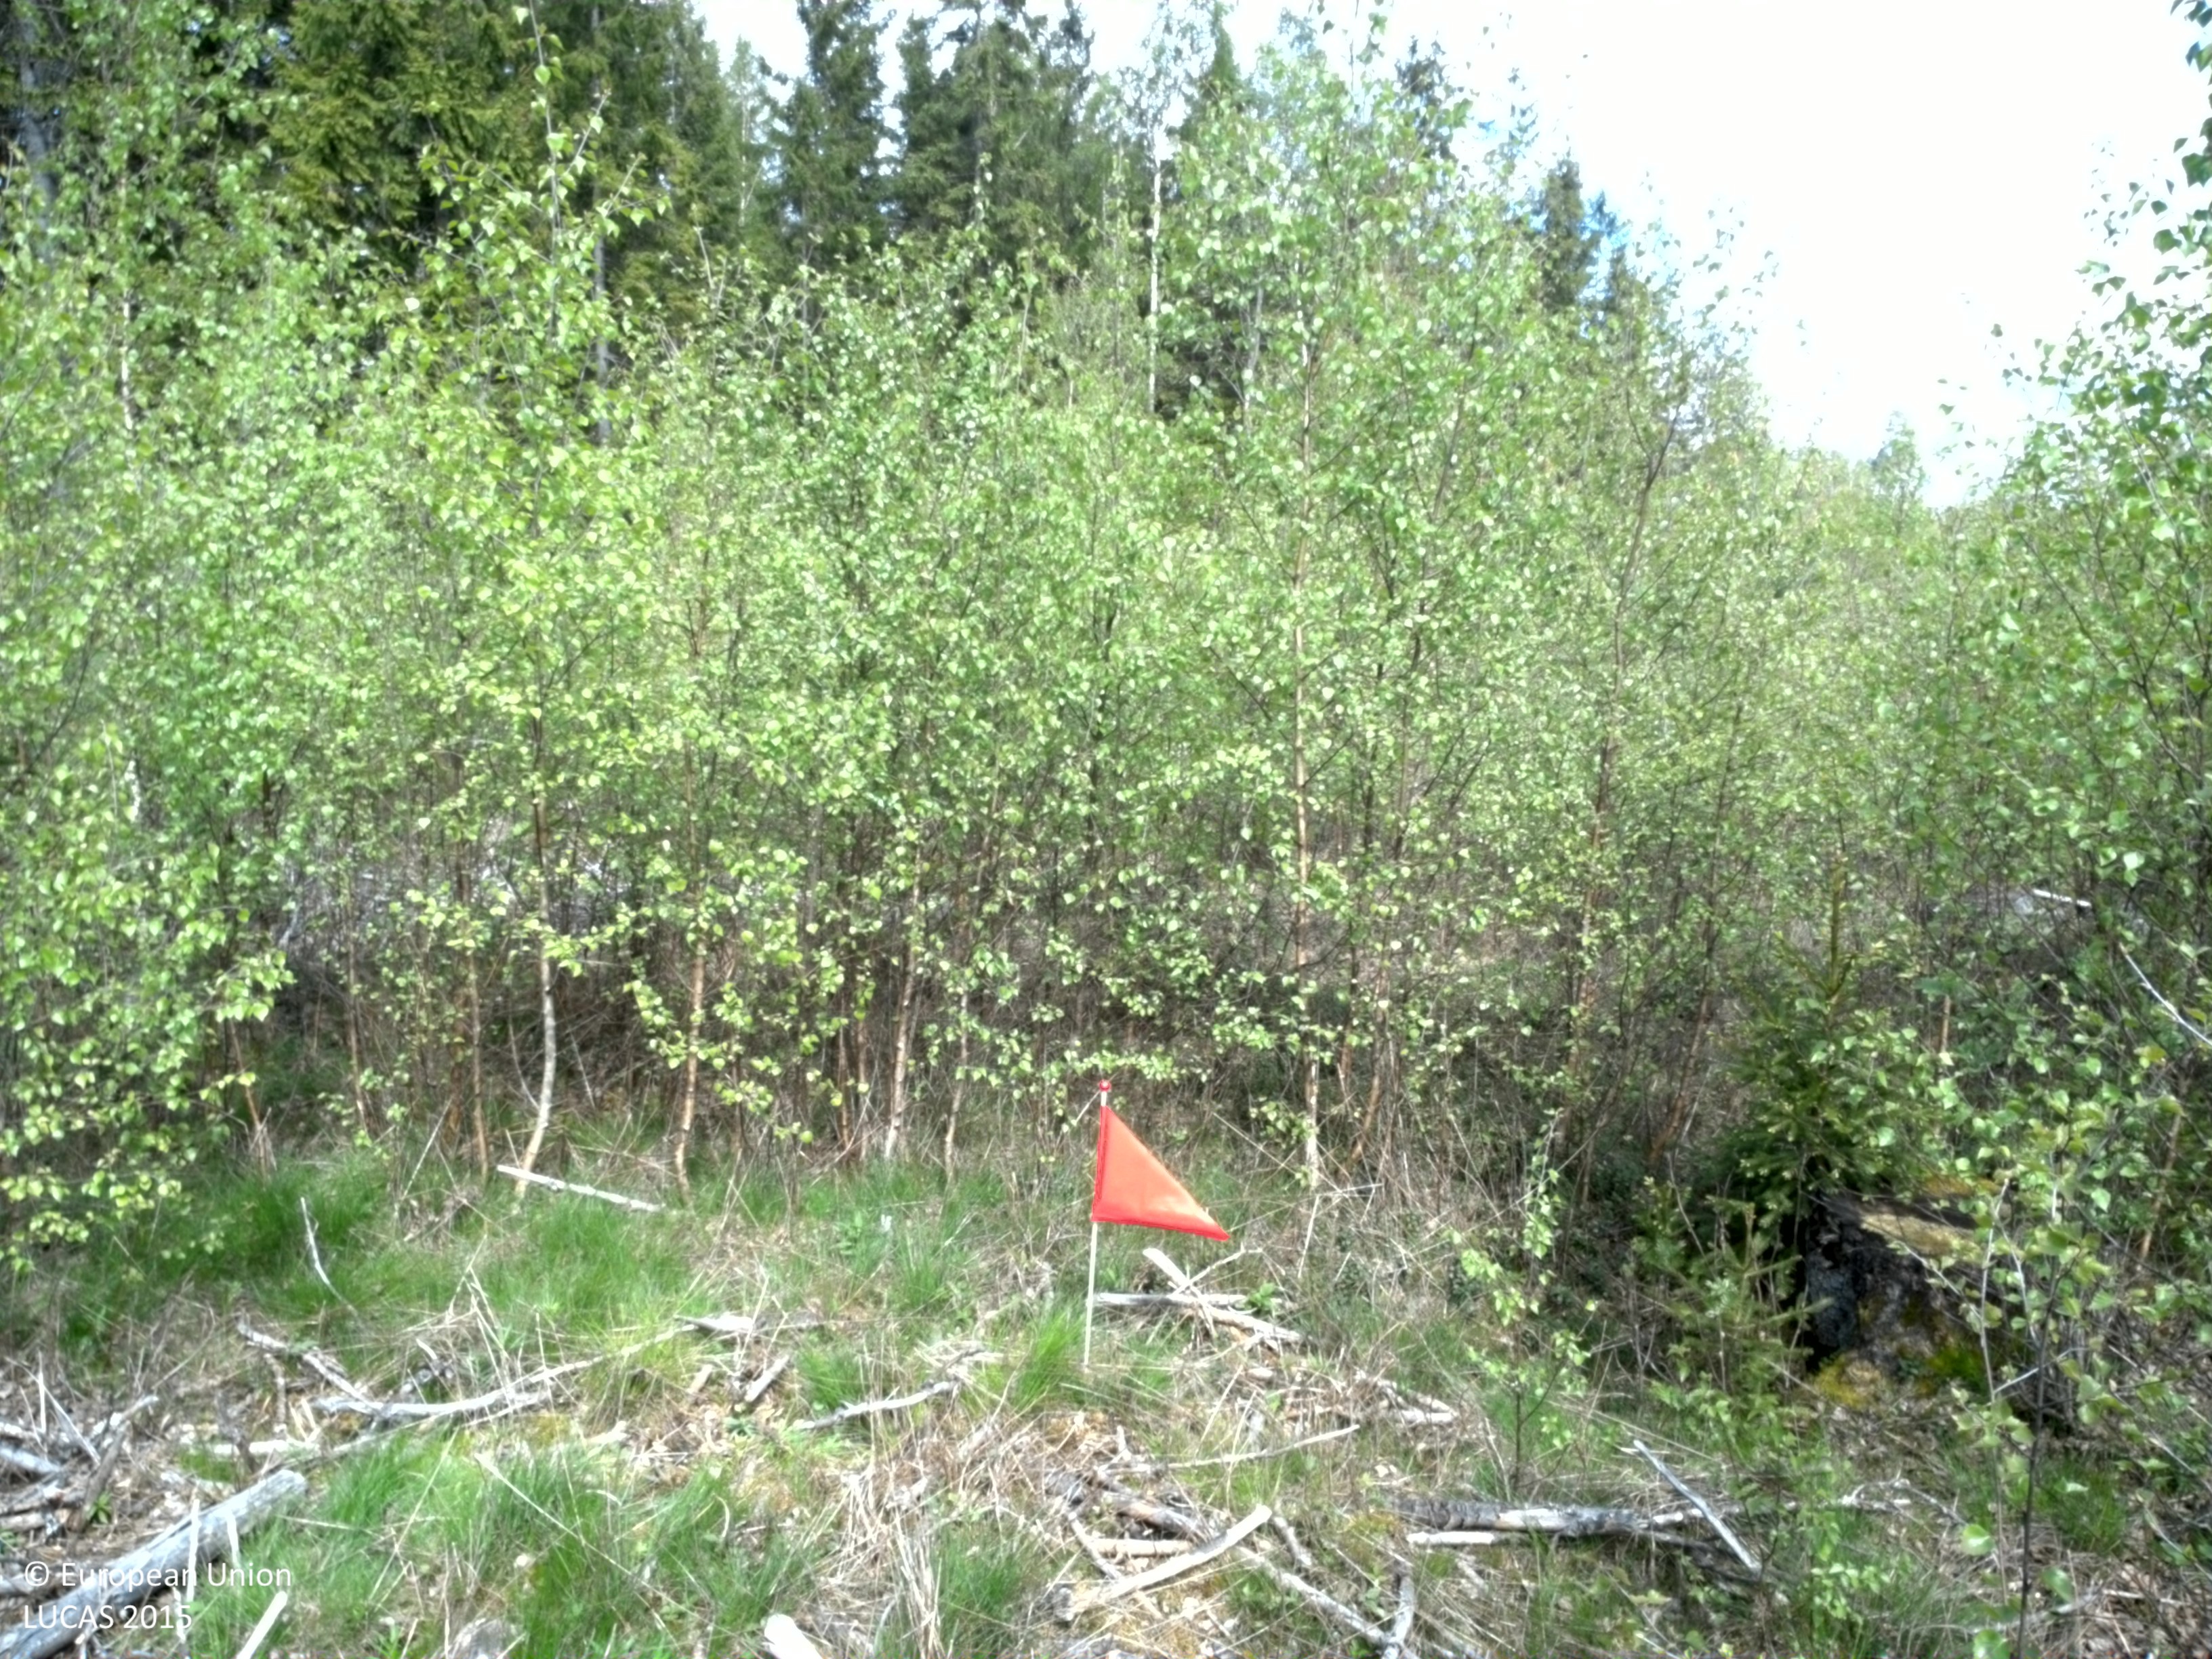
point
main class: Woodland
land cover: Broadleaved woodland
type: boreal forest
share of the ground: > 75 %
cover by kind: broadleaved forest trees 80 %, coniferous forest trees 10 %, lichens and mosses 10 %
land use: Forestry
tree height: < 5 m
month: May
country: SE
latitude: 56.6868
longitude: 14.4540
